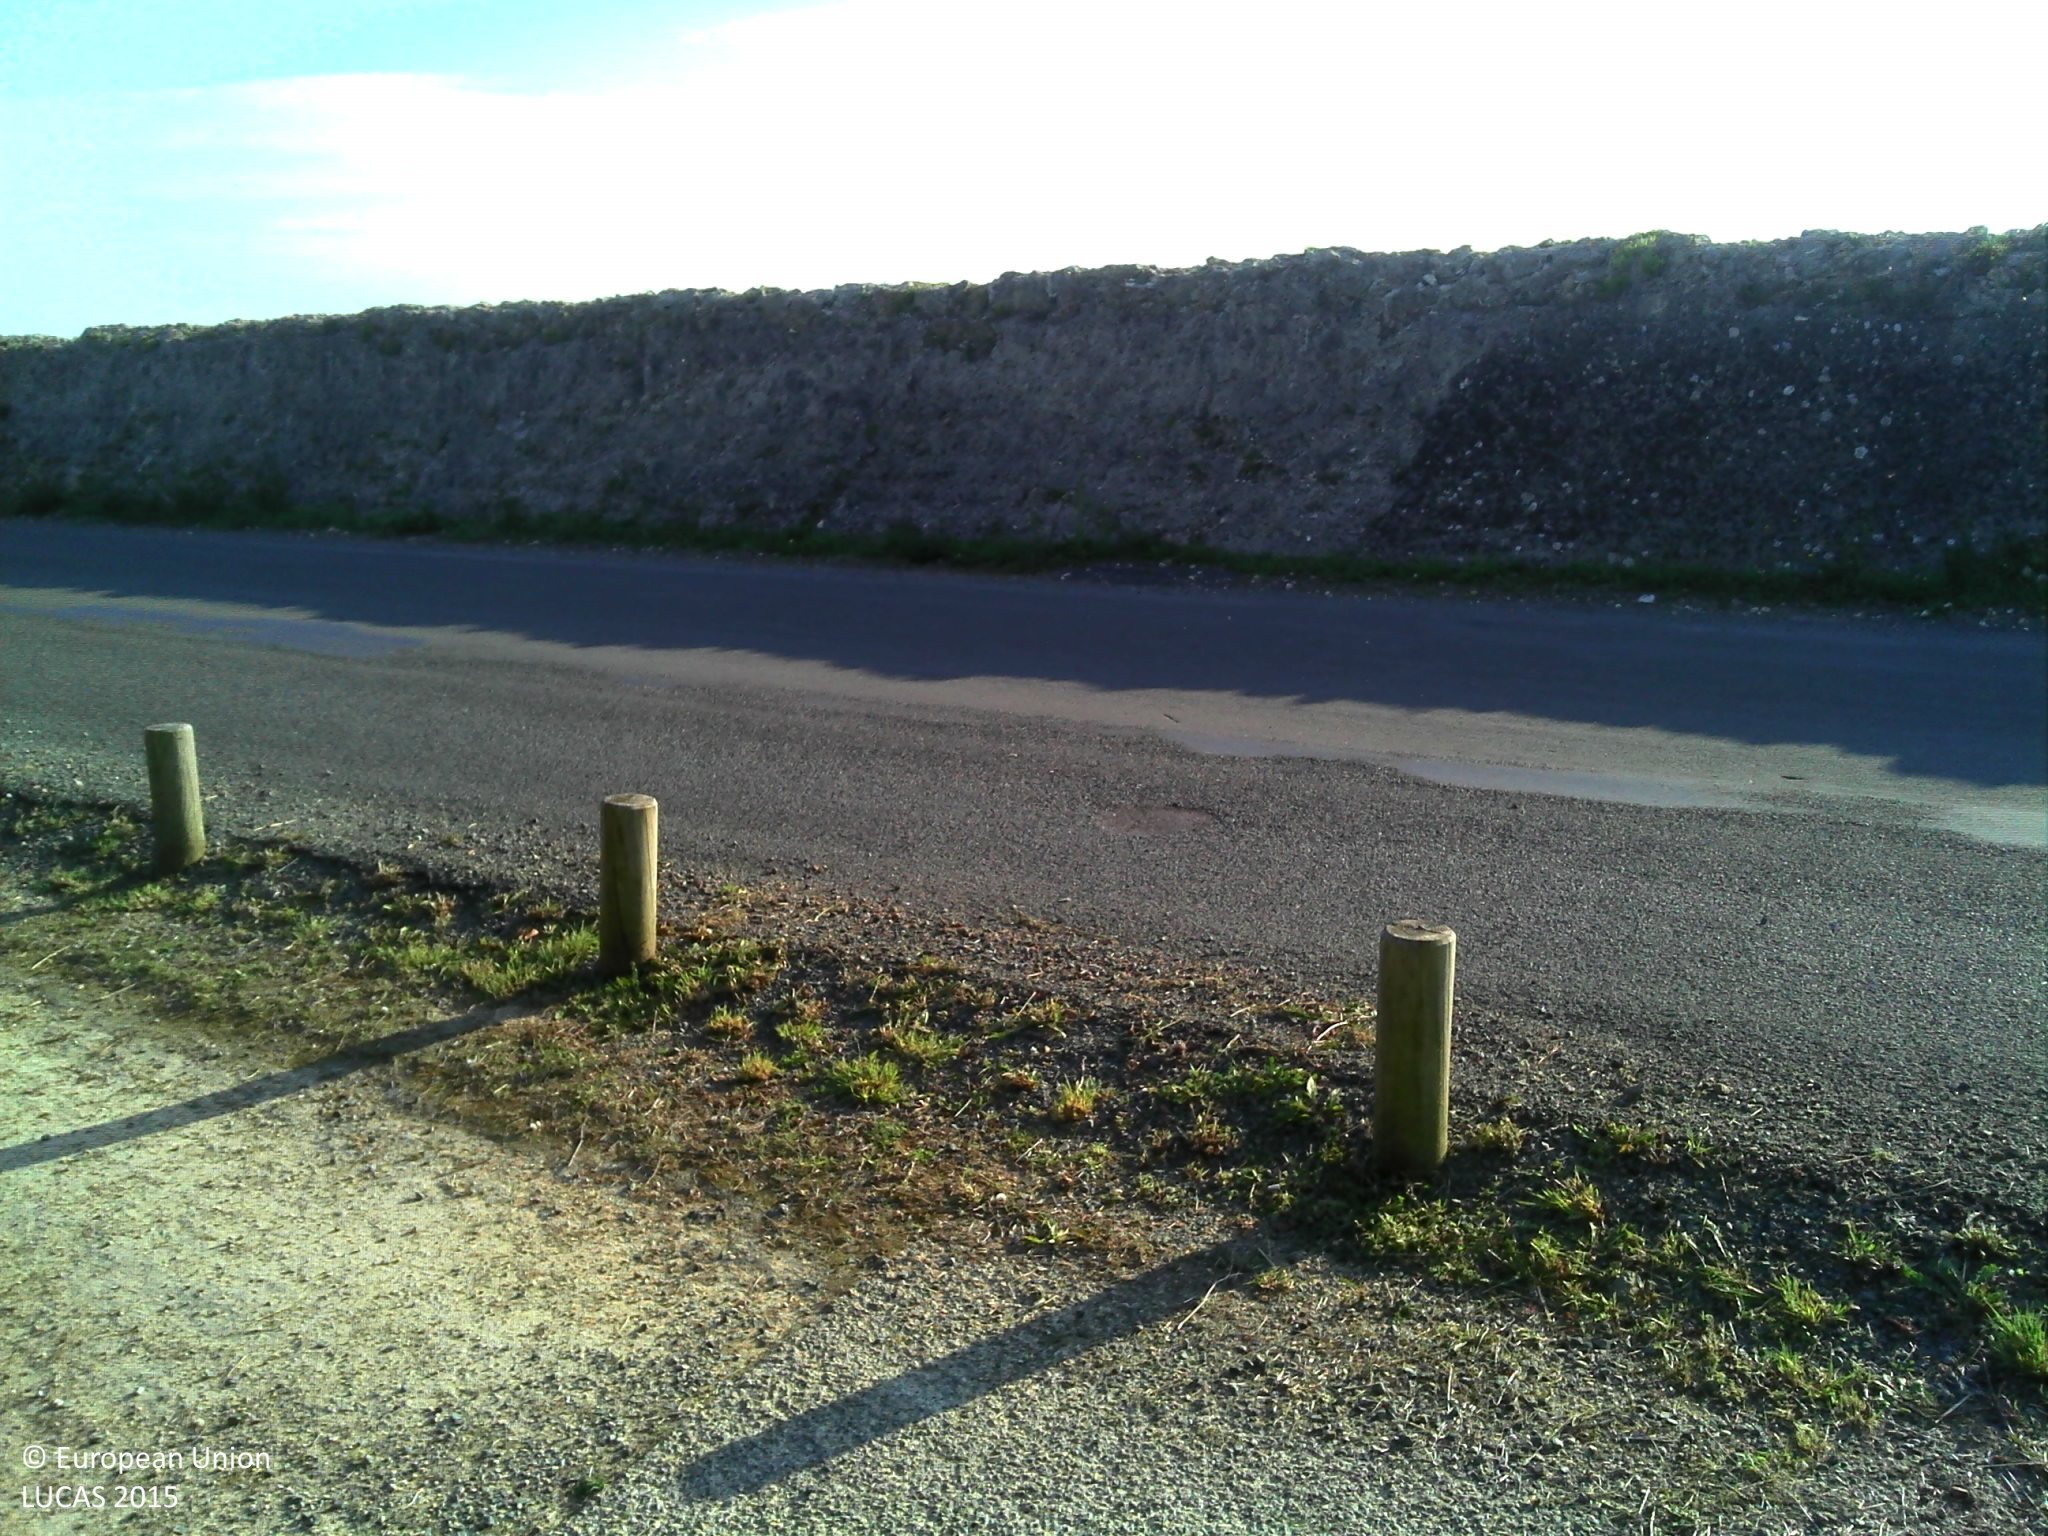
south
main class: Woodland
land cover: Other coniferous woodland
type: exotic forest
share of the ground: > 75 %
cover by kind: coniferous forest trees 85 %, herbaceous plants 15 %
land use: Road transport
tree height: < 5 m
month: October
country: FR
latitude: 46.2996
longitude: -1.2639
